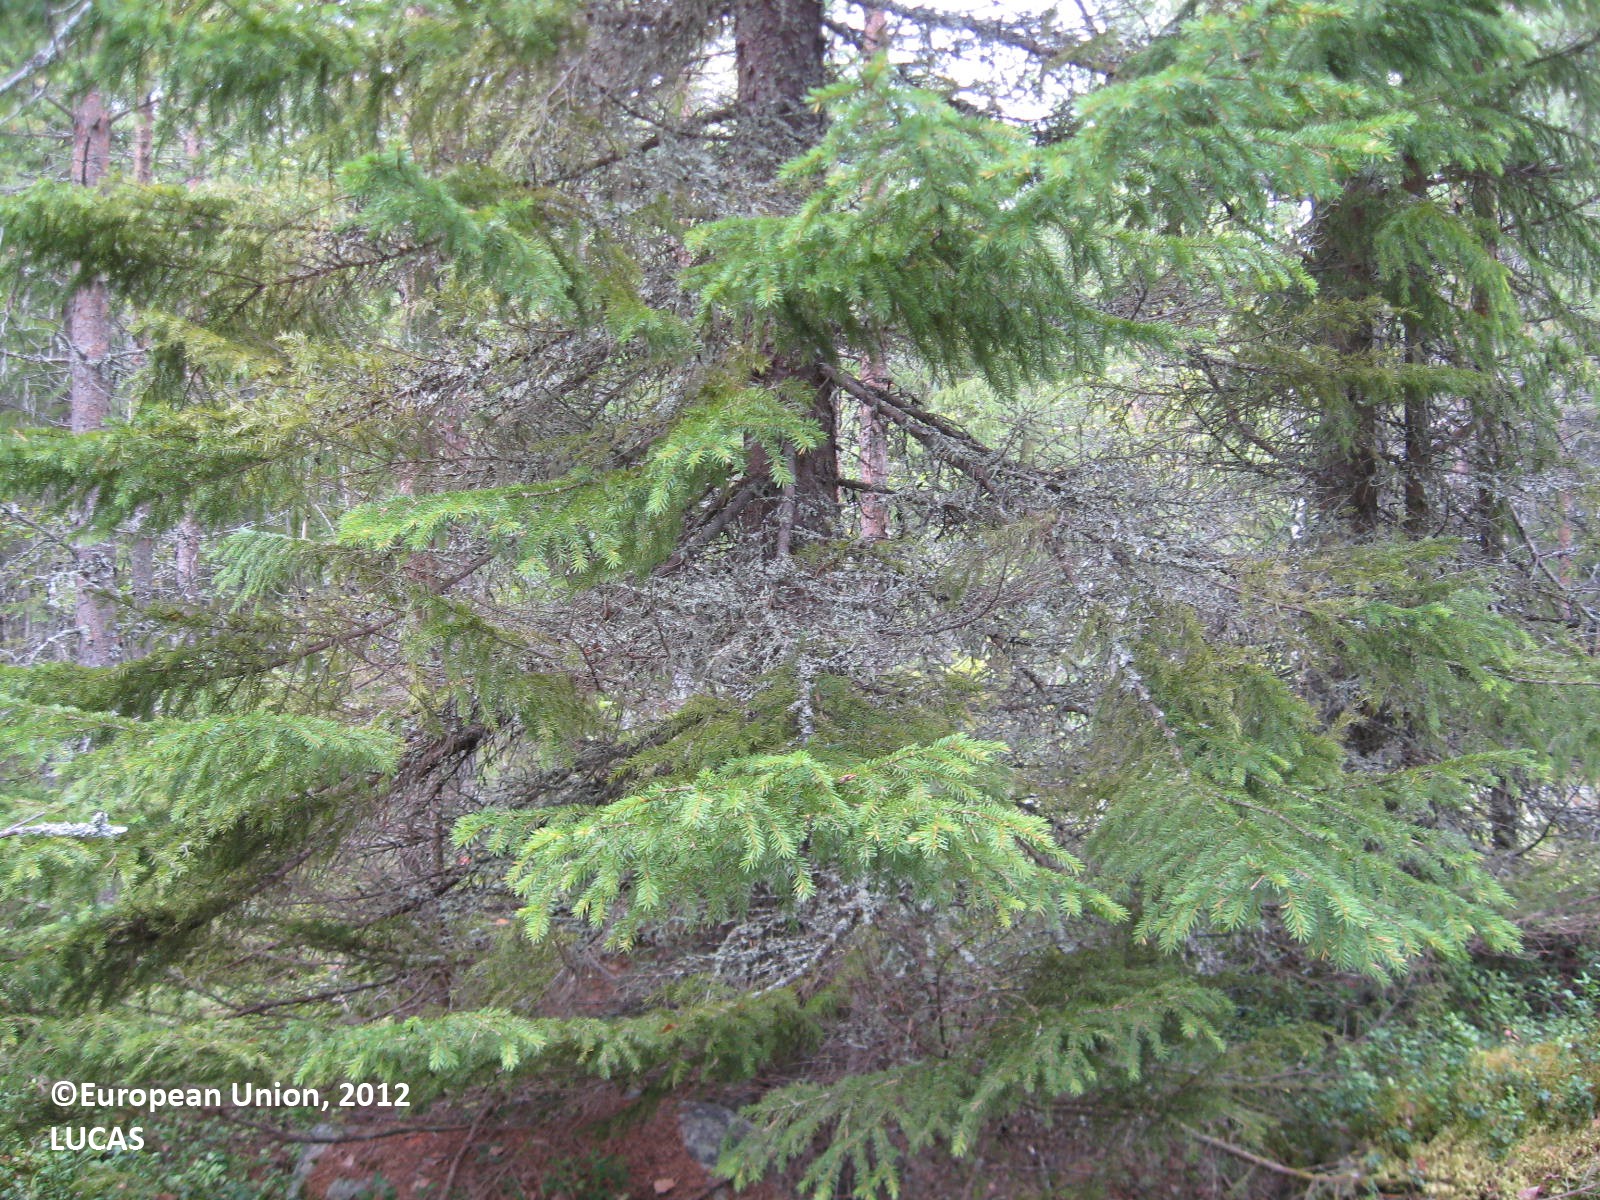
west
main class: Woodland
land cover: Pine dominated mixed woodland
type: boreal forest
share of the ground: > 75 %
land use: Forestry
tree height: > 5 m
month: August
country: FI
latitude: 63.5514
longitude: 29.8623
